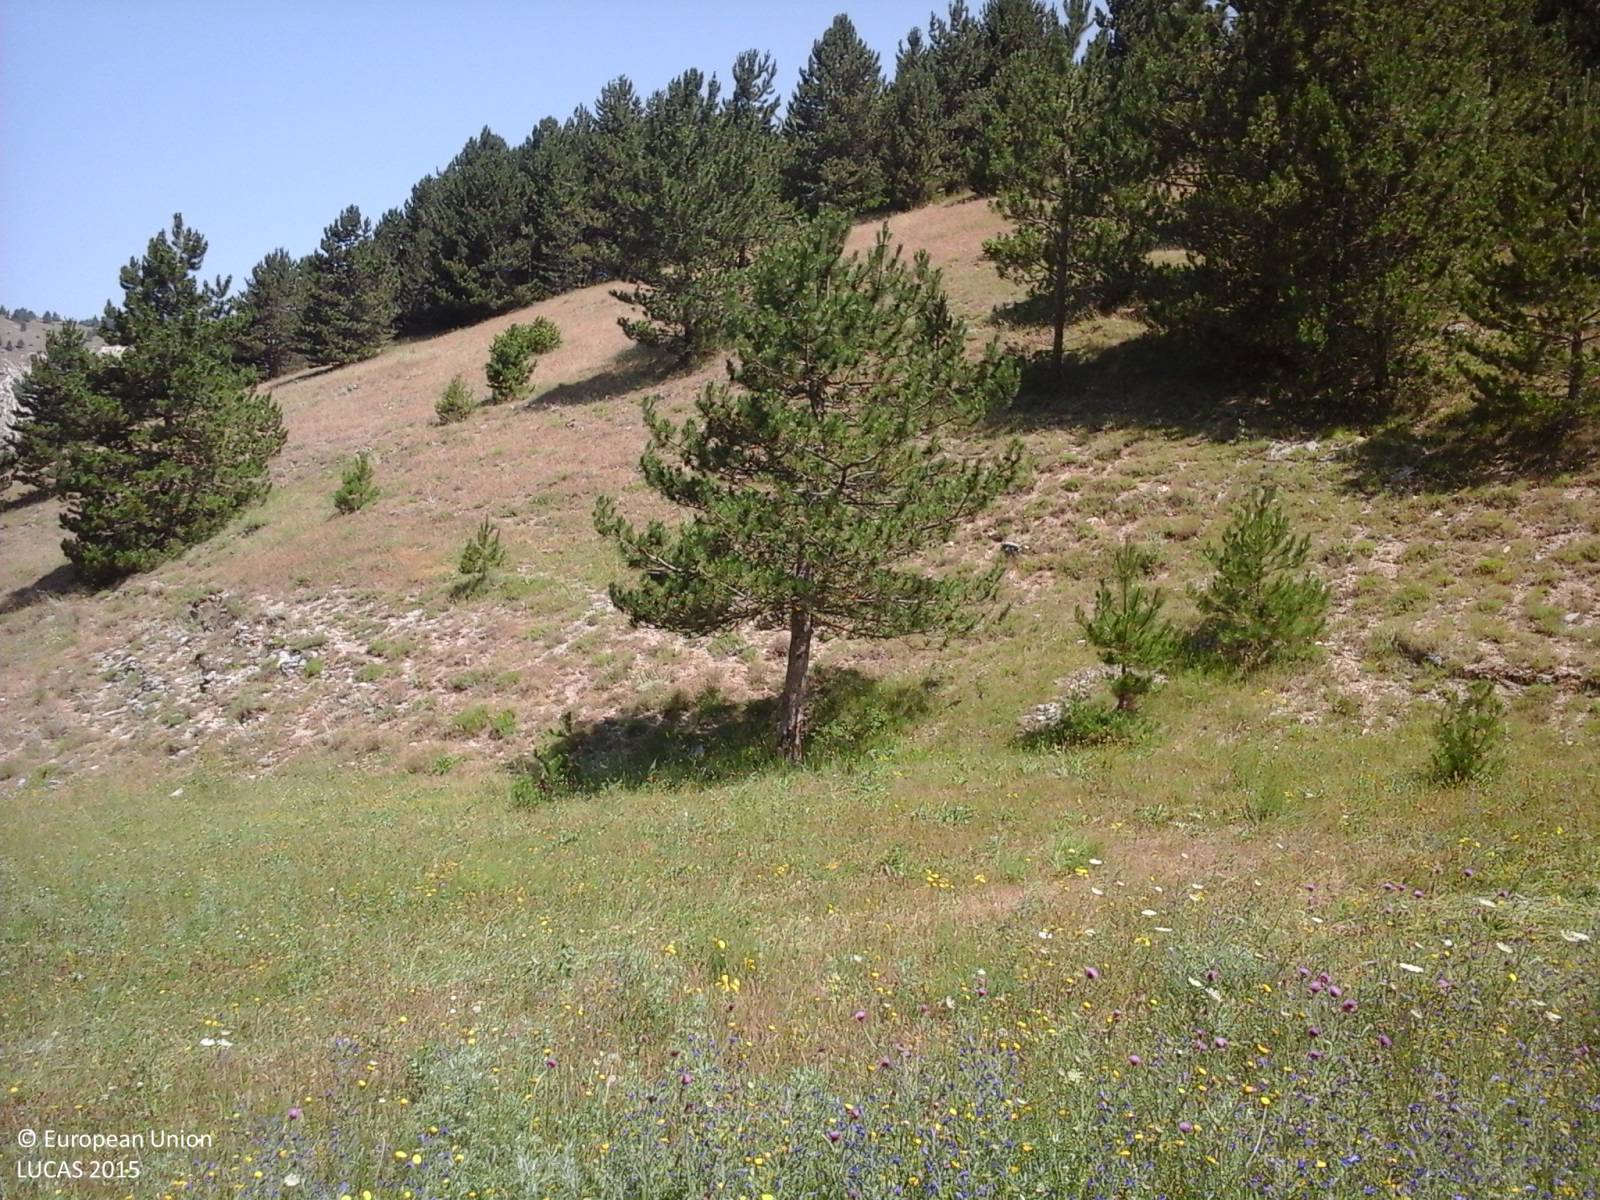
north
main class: Grassland
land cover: Grassland without tree/shrub cover
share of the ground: > 75 %
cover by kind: herbaceous plants 100 %
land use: Agriculture (excluding fallow land and kitchen gardens)
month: July
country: IT
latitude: 42.4161
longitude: 13.4040
